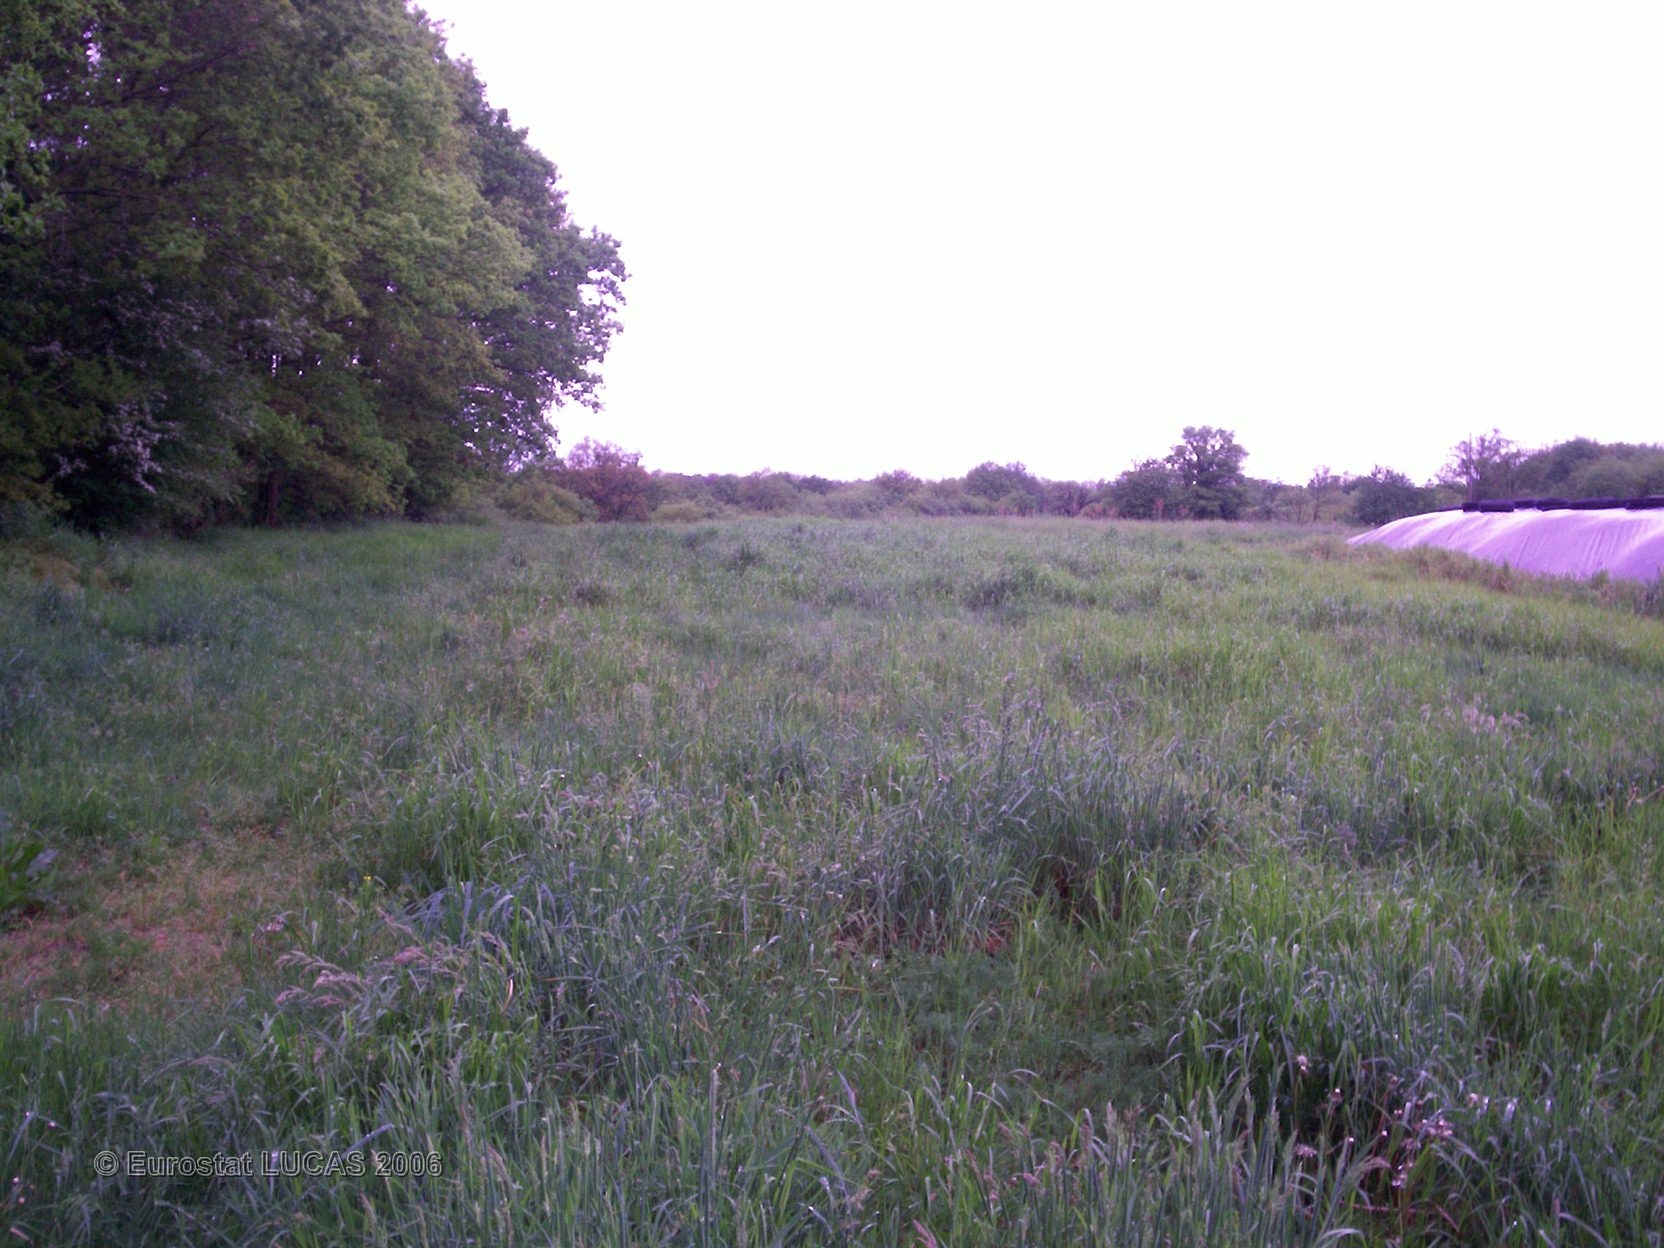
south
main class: Grassland
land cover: Grassland without tree/shrub cover
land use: Logistics and storage
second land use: Agriculture (excluding fallow land and kitchen gardens)
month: May
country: FR
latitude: 46.0306
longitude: 0.4365
